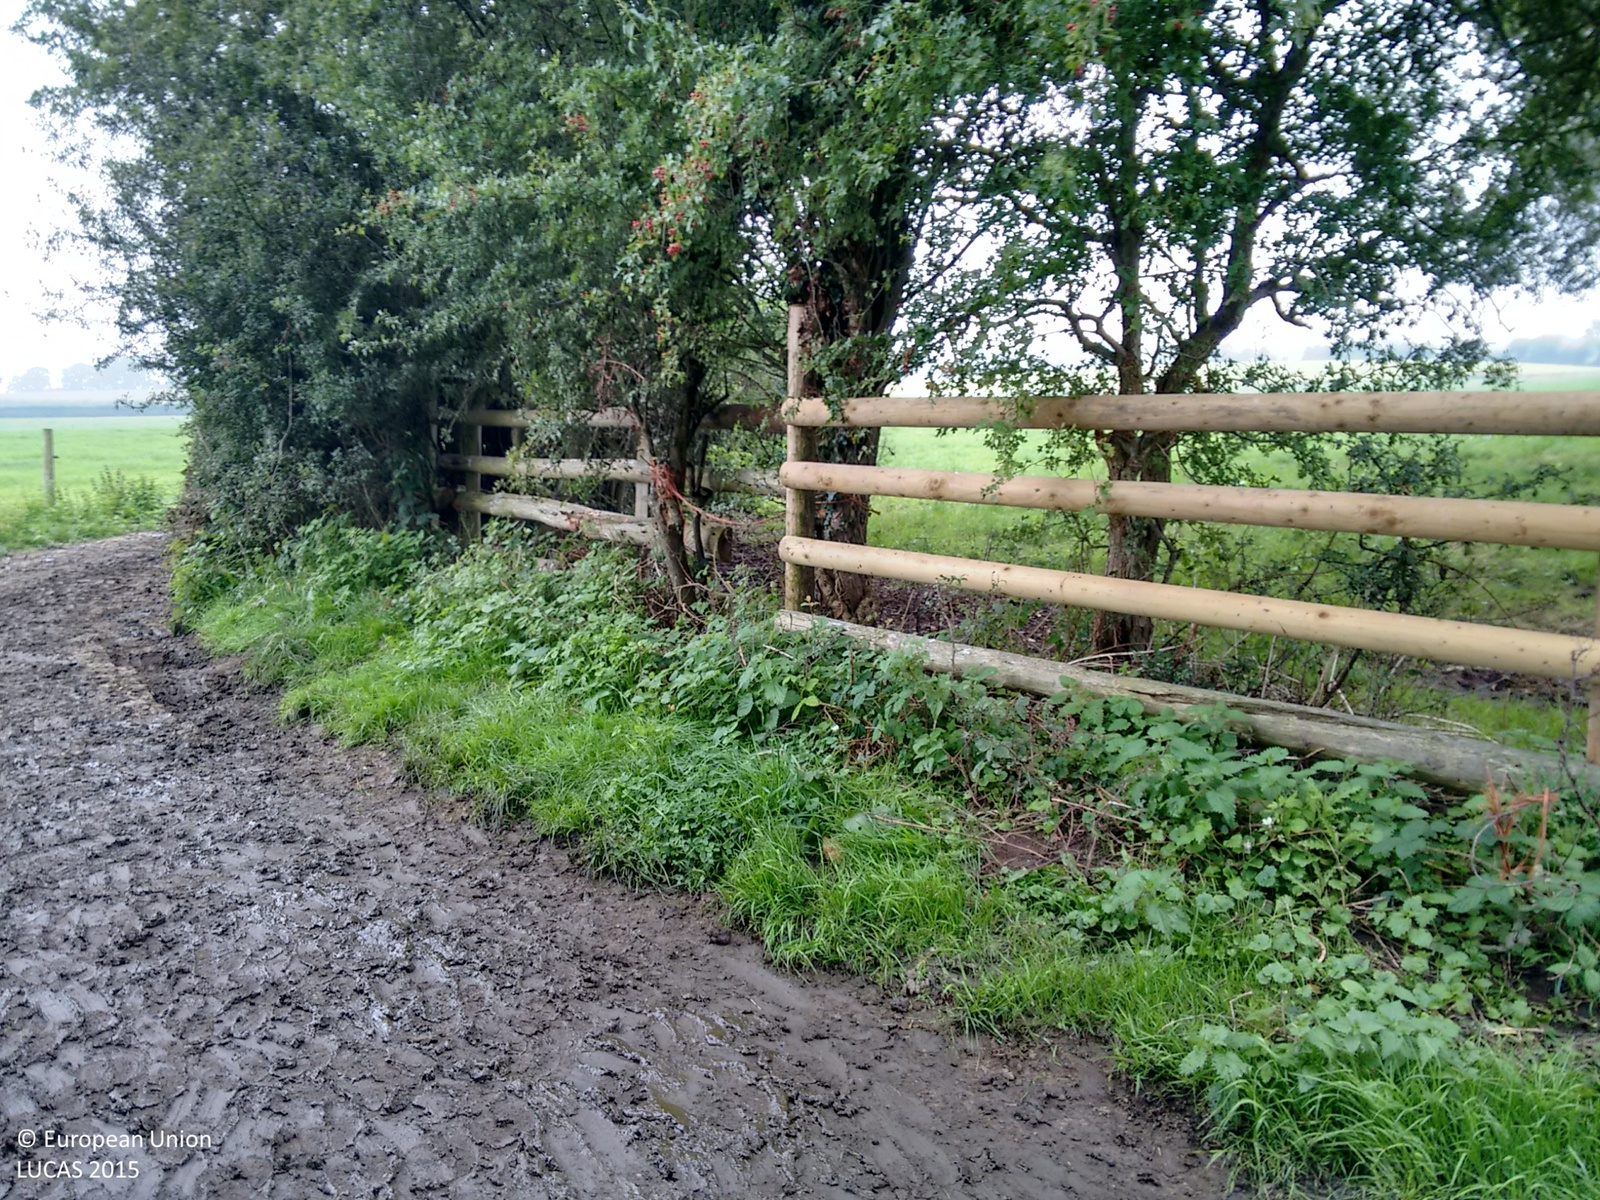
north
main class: Grassland
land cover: Grassland without tree/shrub cover
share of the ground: > 75 %
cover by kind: herbaceous plants 100 %
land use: Agriculture (excluding fallow land and kitchen gardens)
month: September
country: GB
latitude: 52.6547
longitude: -2.8896
